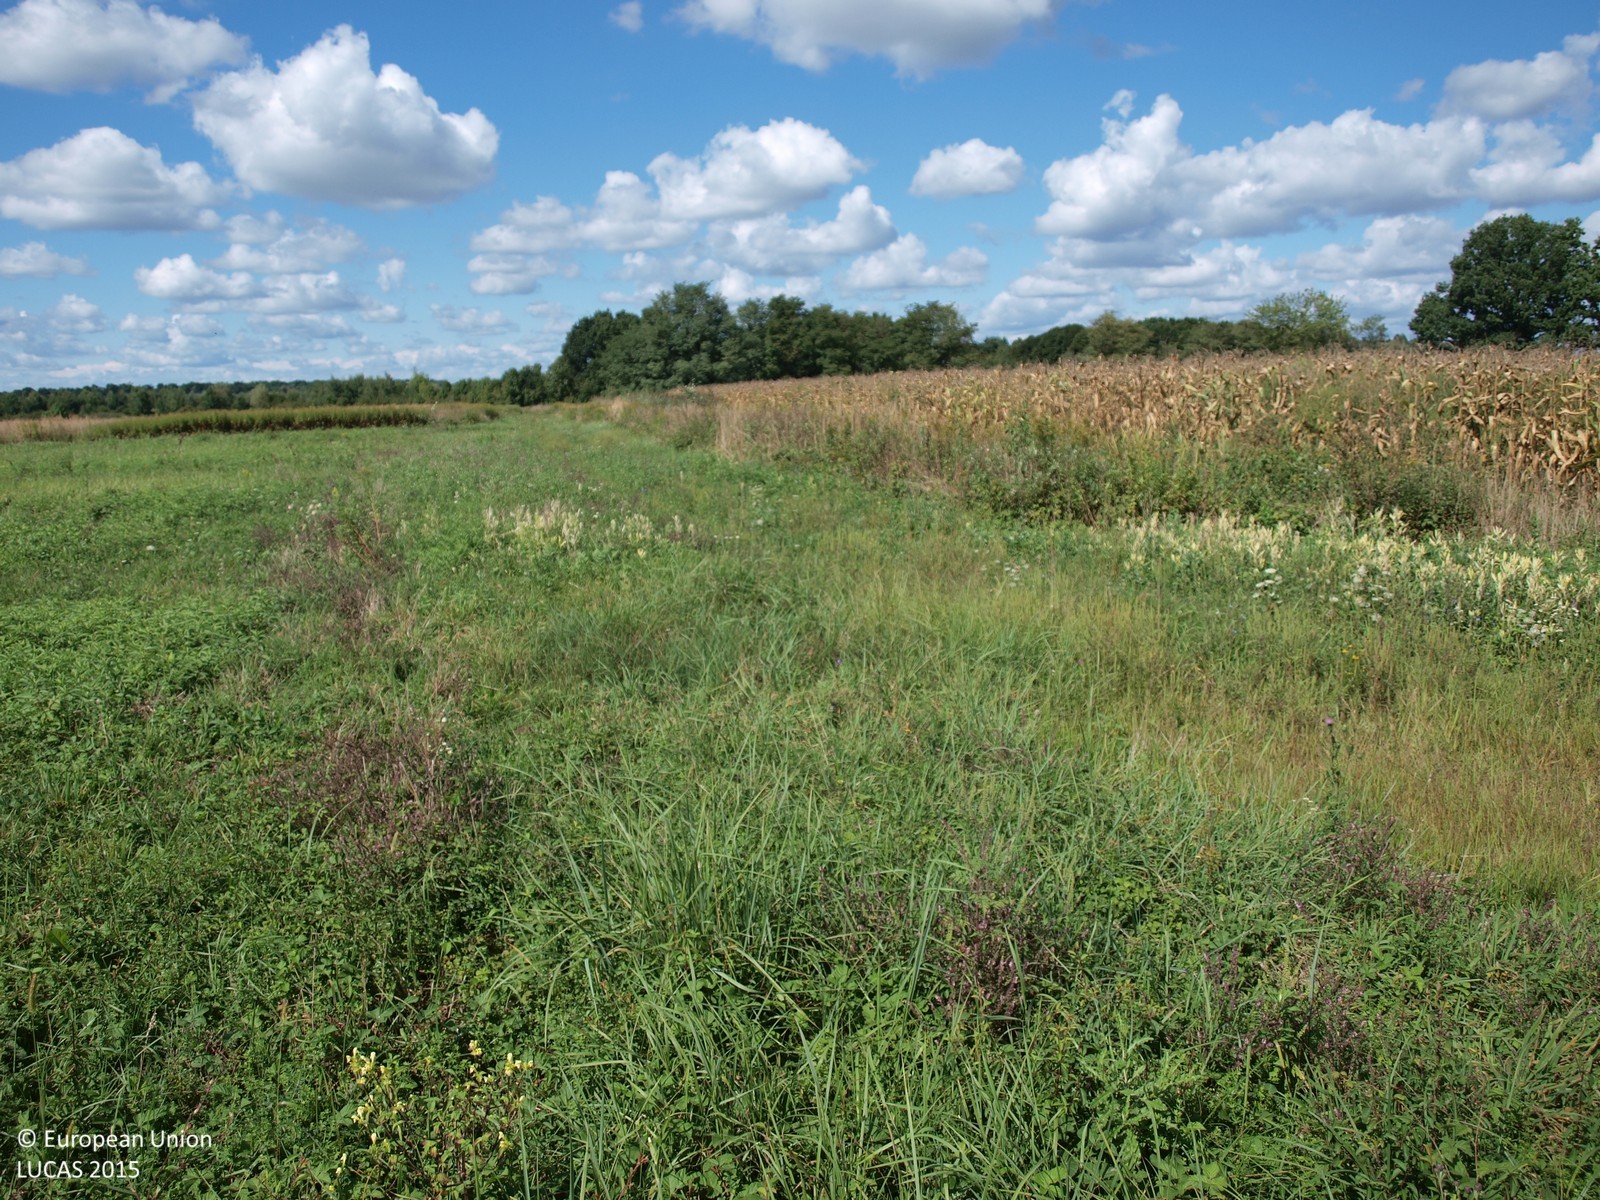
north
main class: Grassland
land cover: Grassland without tree/shrub cover
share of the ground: > 75 %
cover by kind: herbaceous plants 100 %
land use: Semi-natural and natural areas not in use
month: September
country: HR
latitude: 45.7283
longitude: 16.3591
